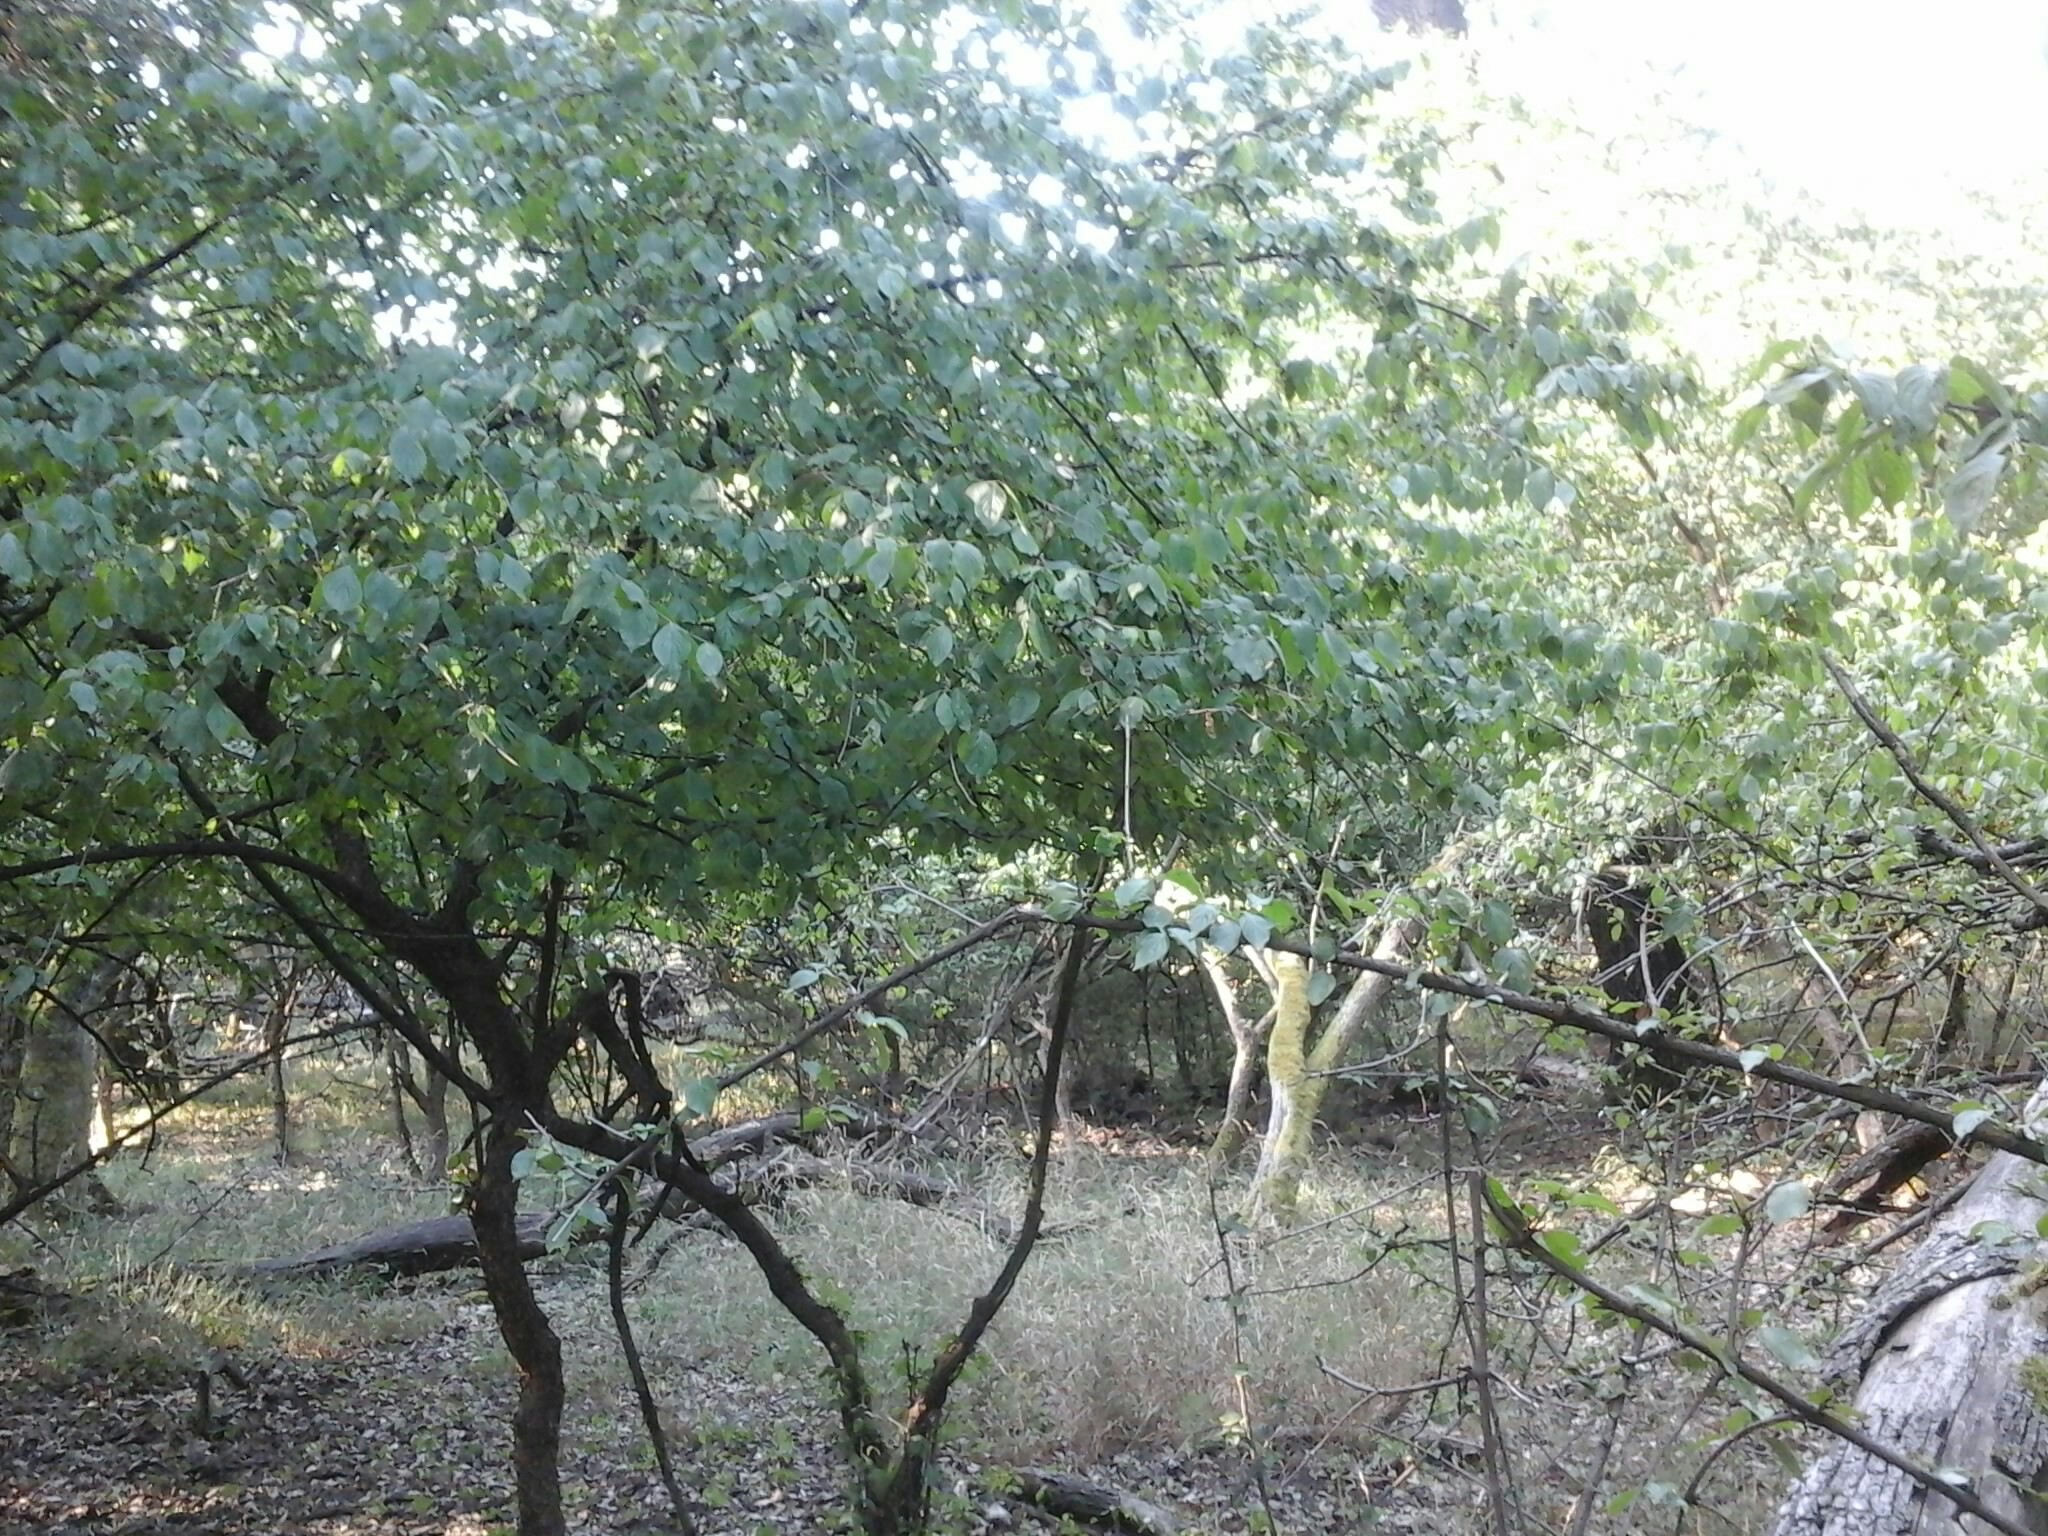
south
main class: Woodland
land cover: Broadleaved woodland
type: mesophytic deciduous forest
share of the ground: > 75 %
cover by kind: broadleaved forest trees 85 %, herbaceous plants 10 %, unconsolidated bare surface 5 %
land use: Forestry
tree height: > 5 m
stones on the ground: < 10 %
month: August
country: HU
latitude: 47.3822
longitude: 18.3440
